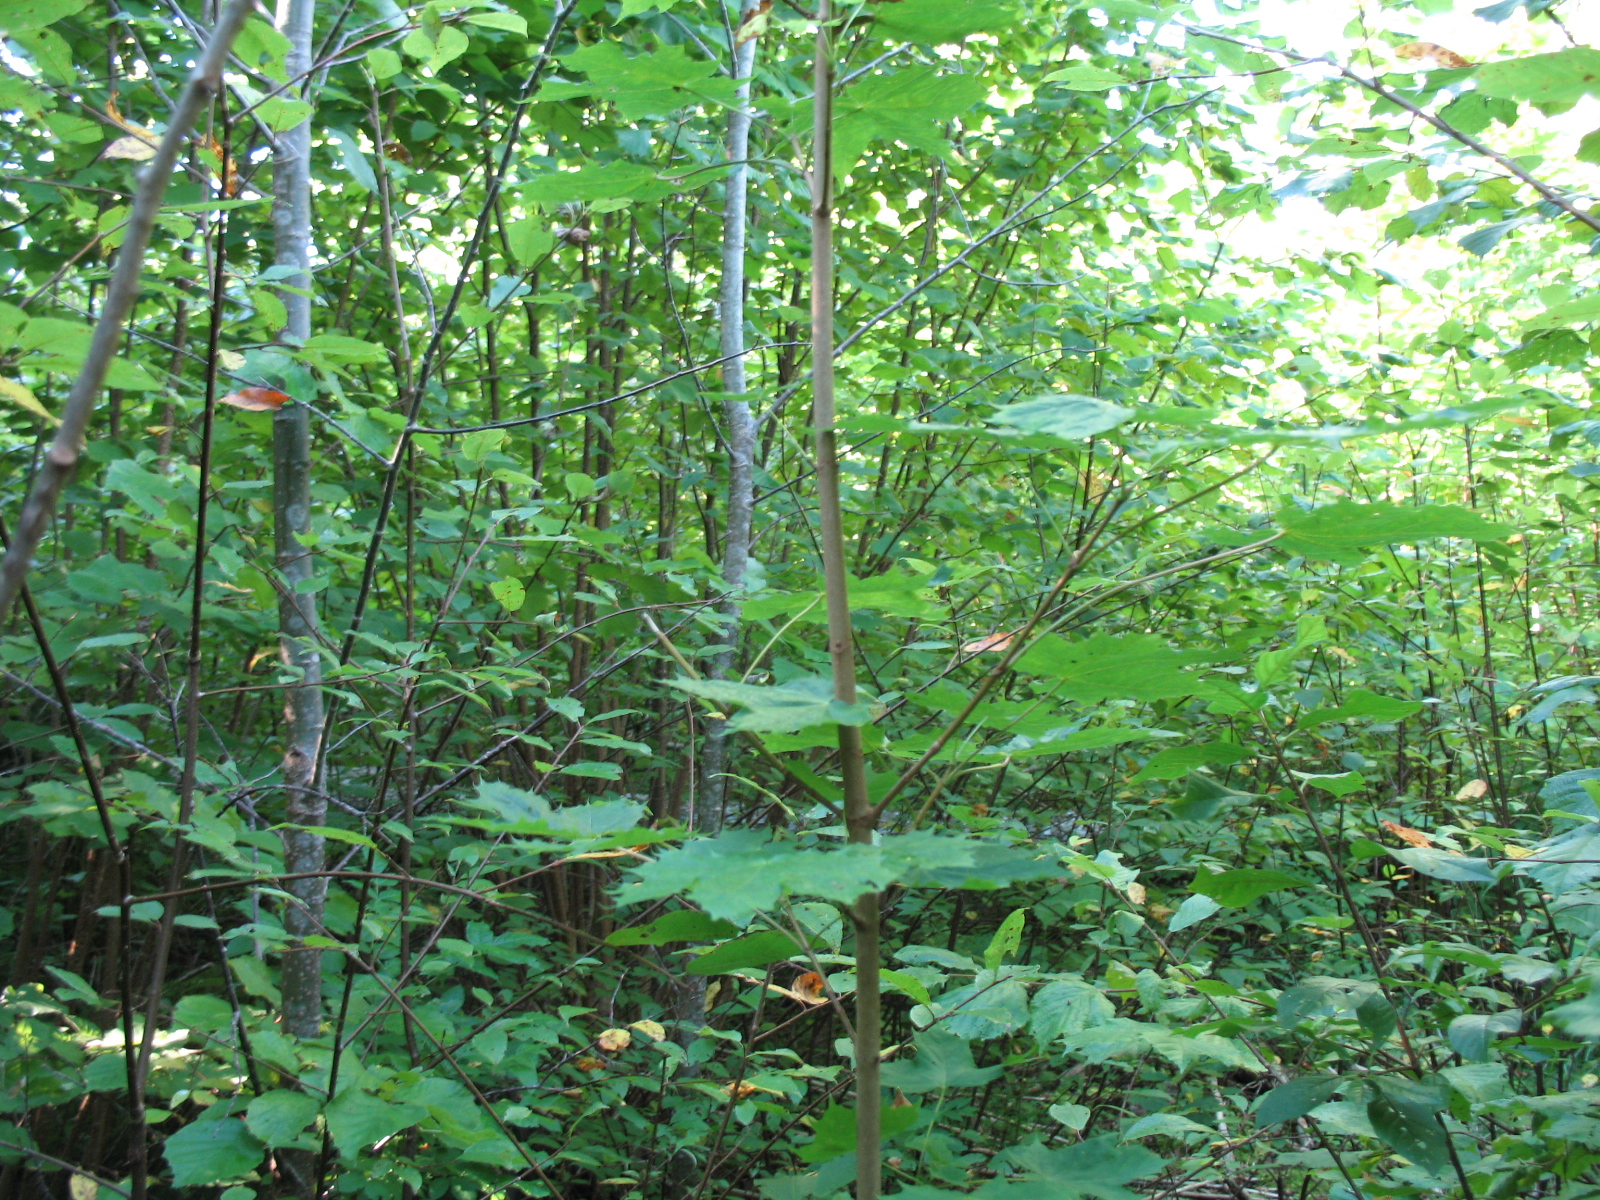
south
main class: Woodland
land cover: Broadleaved woodland
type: non-riverine alder, birch or aspen forest
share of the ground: > 75 %
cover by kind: broadleaved forest trees 90 %, shrubs 5 %, herbaceous plants 5 %
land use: Forestry
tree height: > 5 m
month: August
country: LV
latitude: 56.6061
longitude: 25.7157
